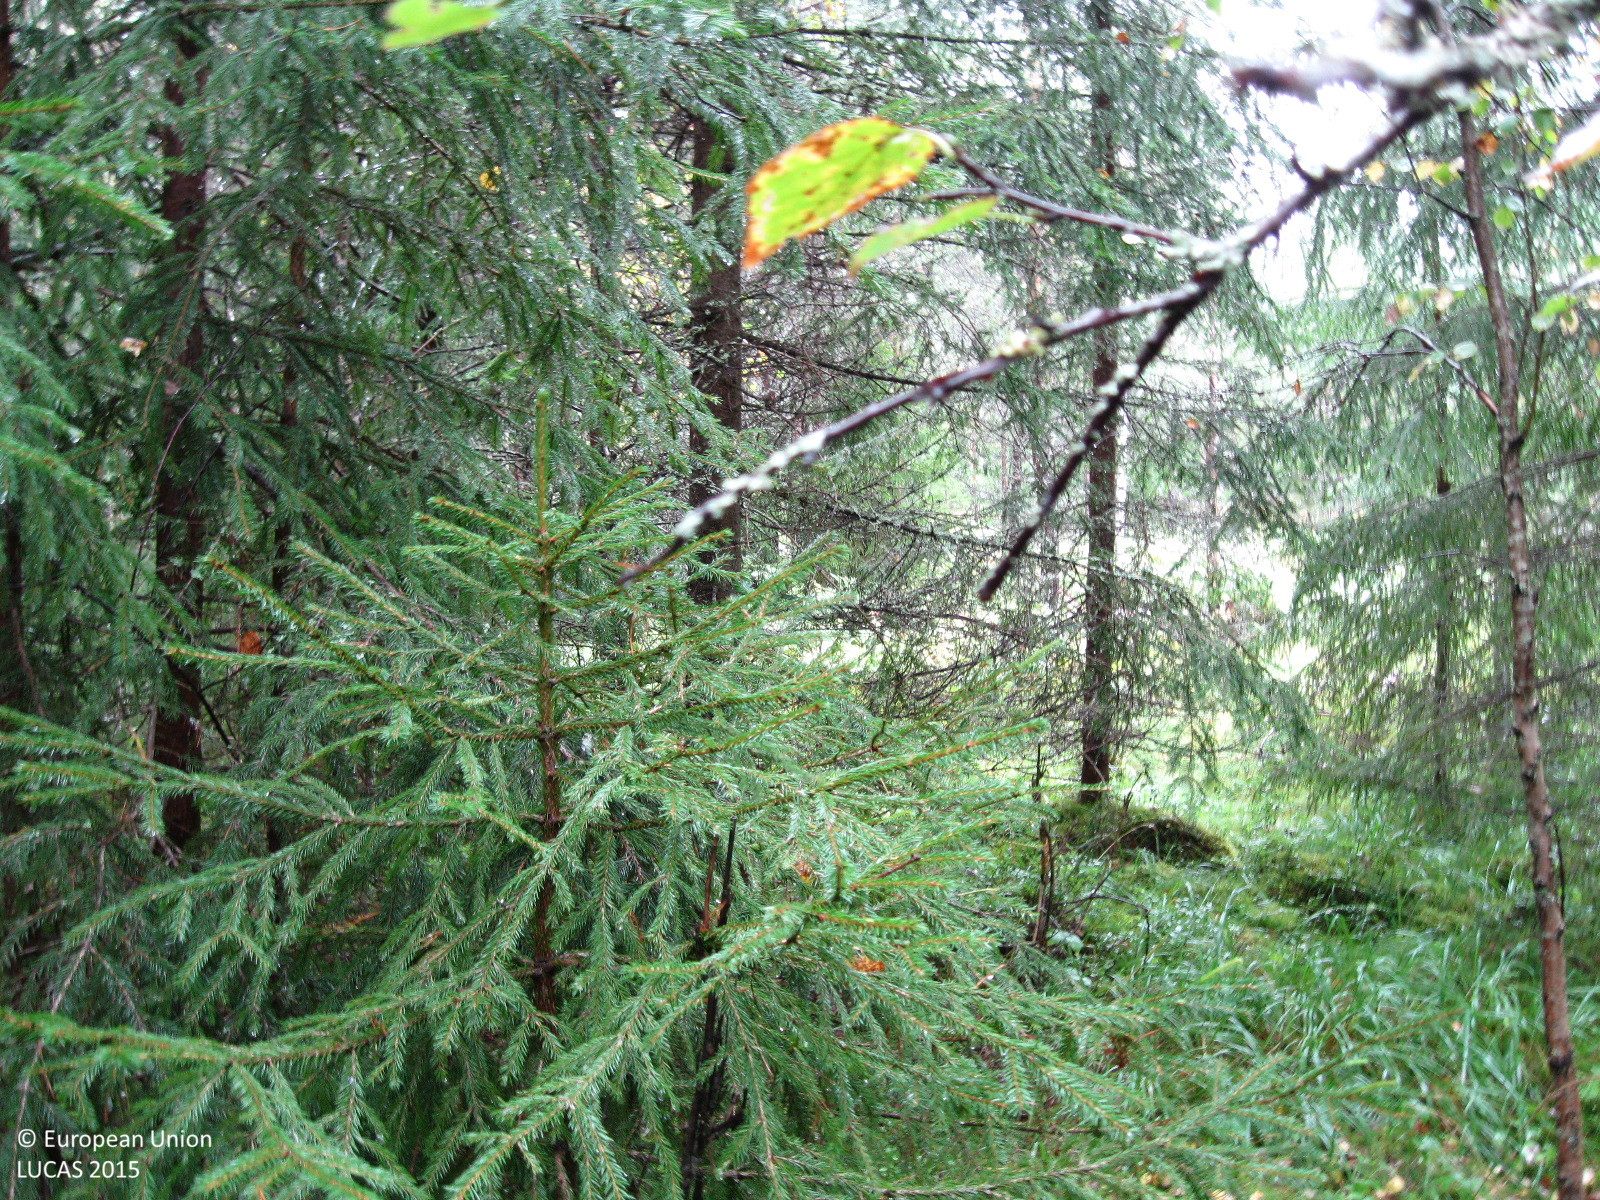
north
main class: Woodland
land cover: Other mixed woodland
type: boreal forest
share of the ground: > 75 %
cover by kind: coniferous forest trees 50 %, broadleaved forest trees 35 %, shrubs 5 %, herbaceous plants 5 %, lichens and mosses 5 %
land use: Semi-natural and natural areas not in use
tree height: > 5 m
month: September
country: FI
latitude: 60.3487
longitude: 24.6252
